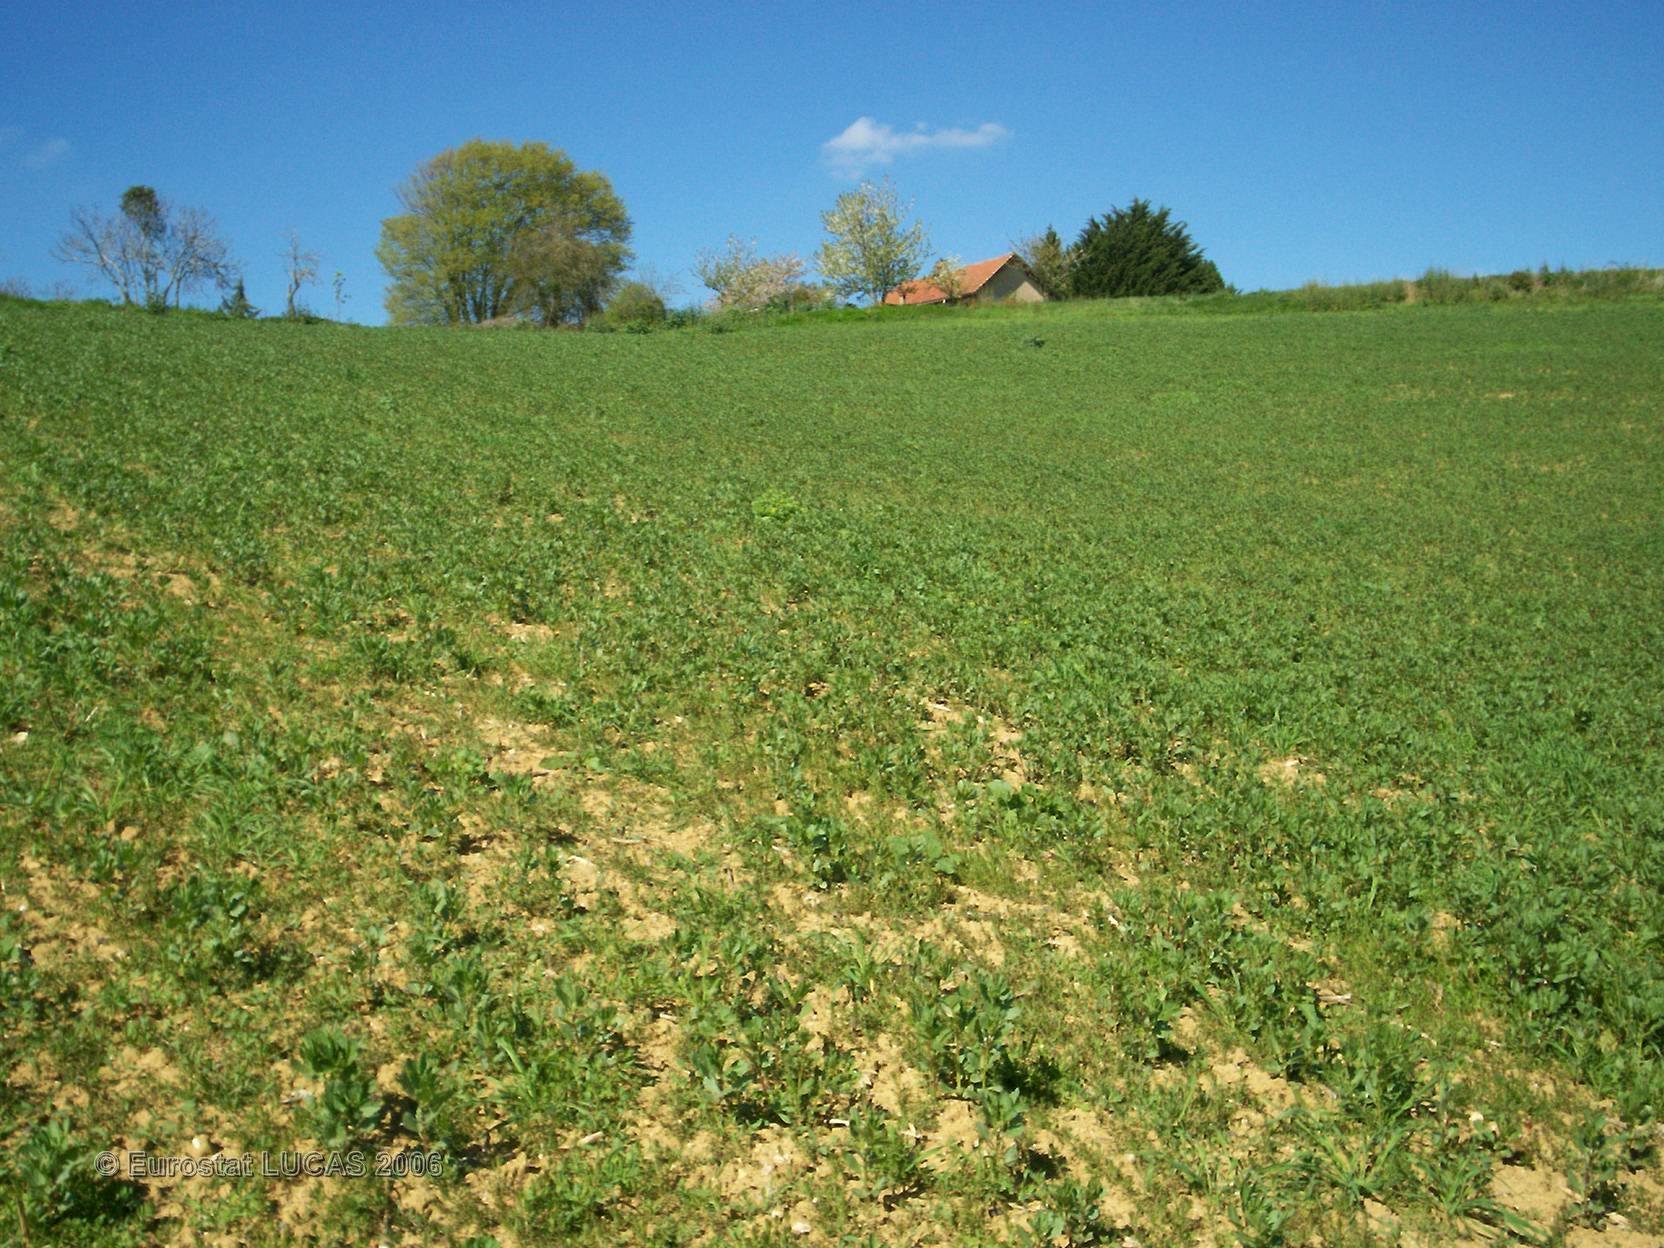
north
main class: Cropland
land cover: Dry pulses
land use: Agriculture (excluding fallow land and kitchen gardens)
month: April
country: FR
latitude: 43.5436
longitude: 0.2311
